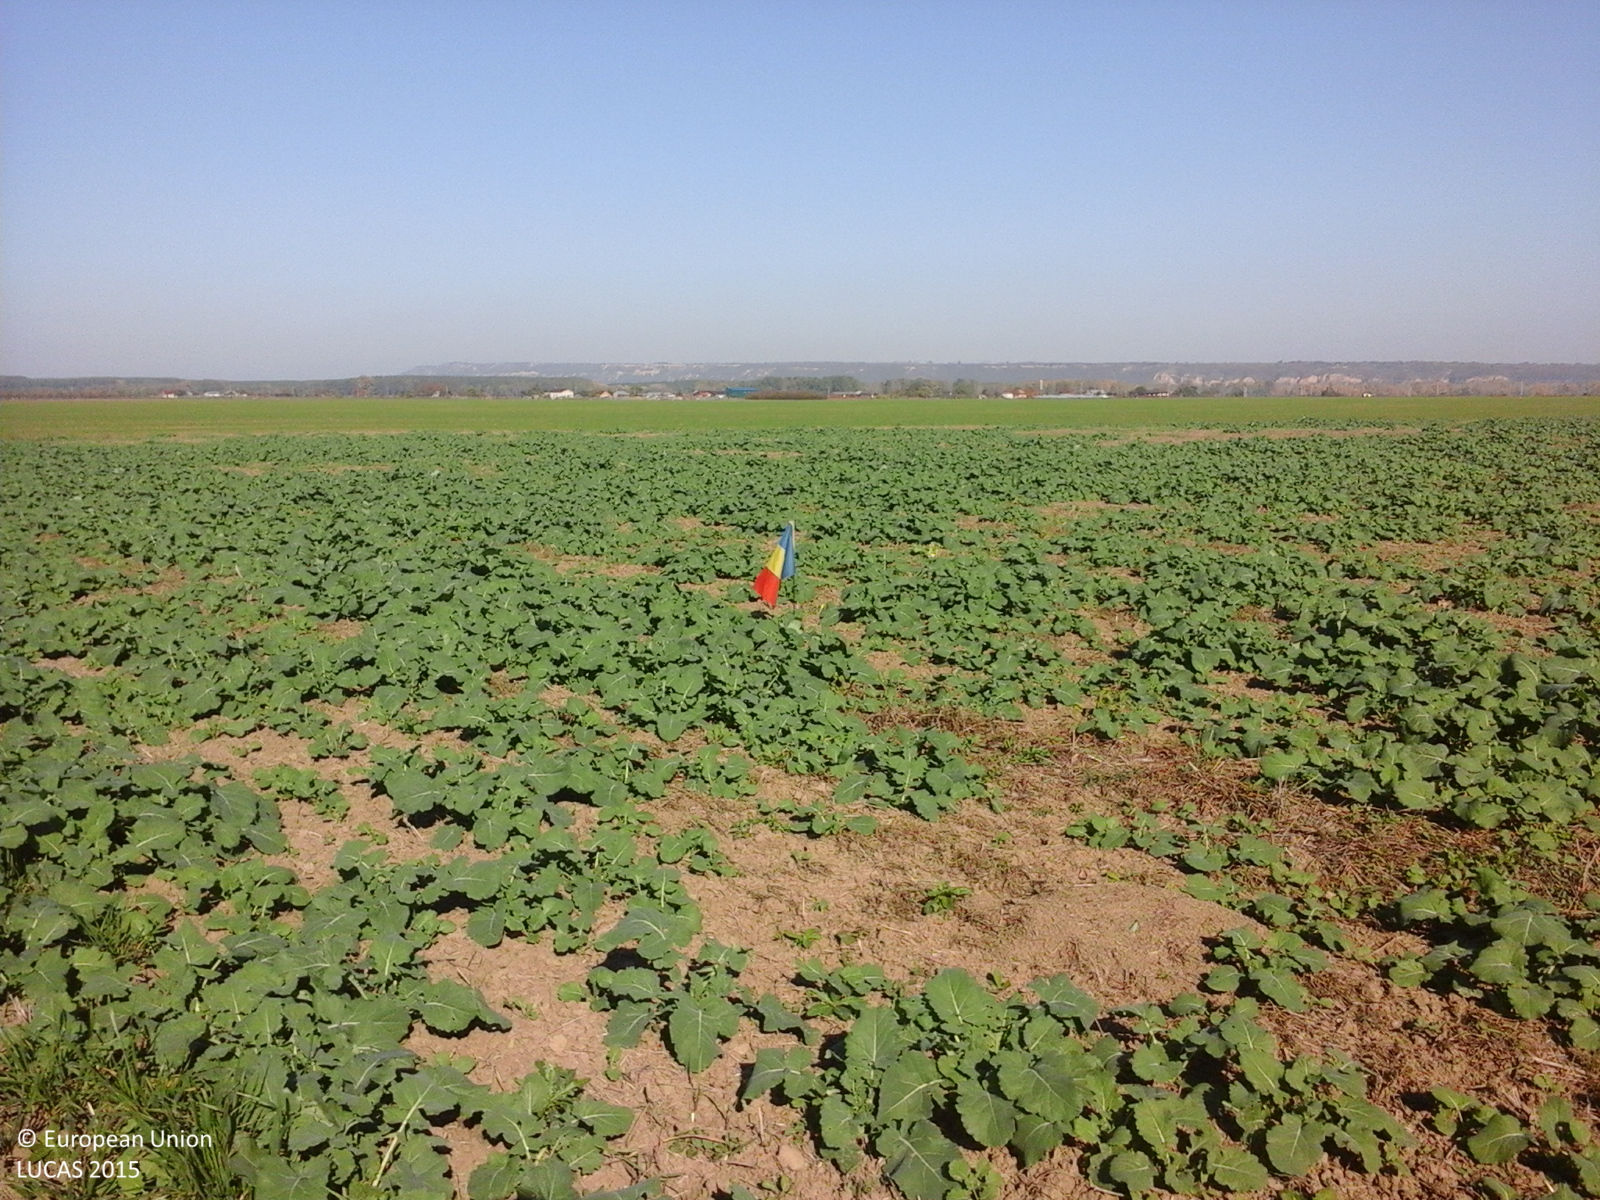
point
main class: Cropland
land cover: Rape and turnip rape
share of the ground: > 75 %
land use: Agriculture (excluding fallow land and kitchen gardens)
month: October
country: RO
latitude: 45.8969
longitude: 27.2265
